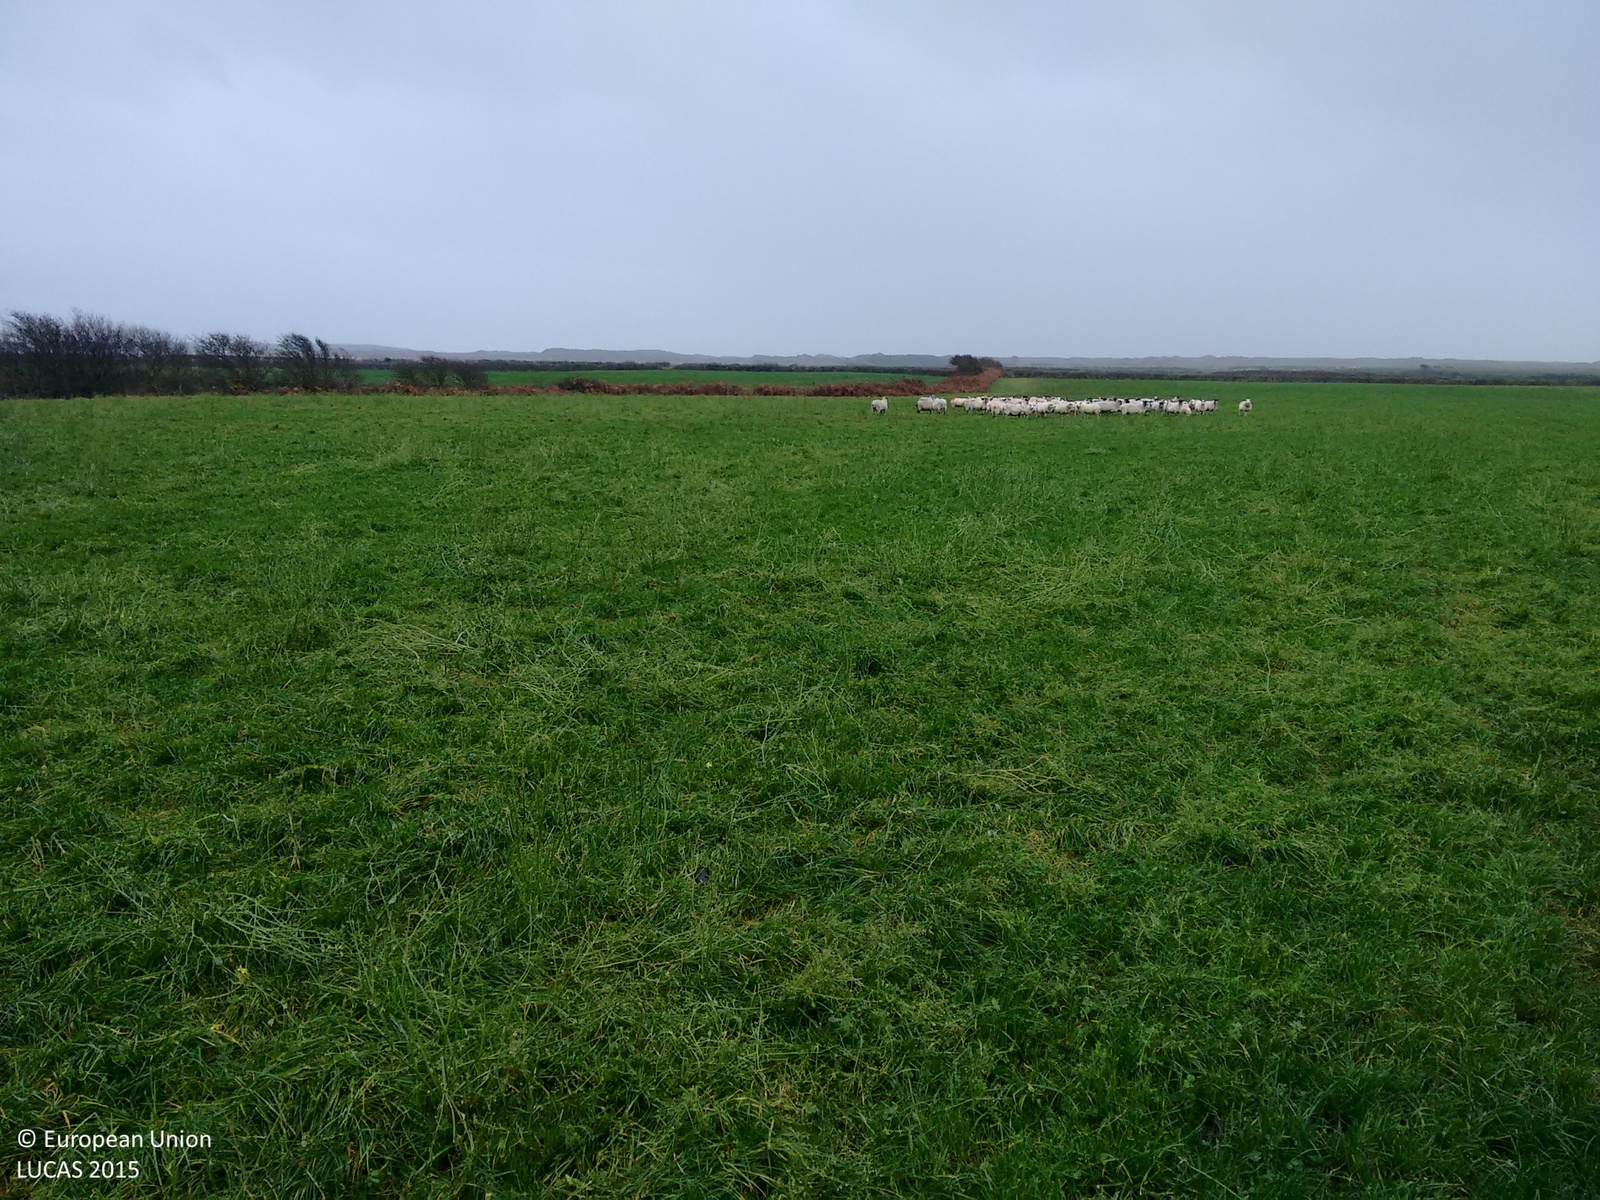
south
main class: Grassland
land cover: Grassland without tree/shrub cover
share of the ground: > 75 %
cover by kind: herbaceous plants 100 %
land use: Agriculture (excluding fallow land and kitchen gardens)
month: November
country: GB
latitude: 54.3648
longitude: -3.4244
